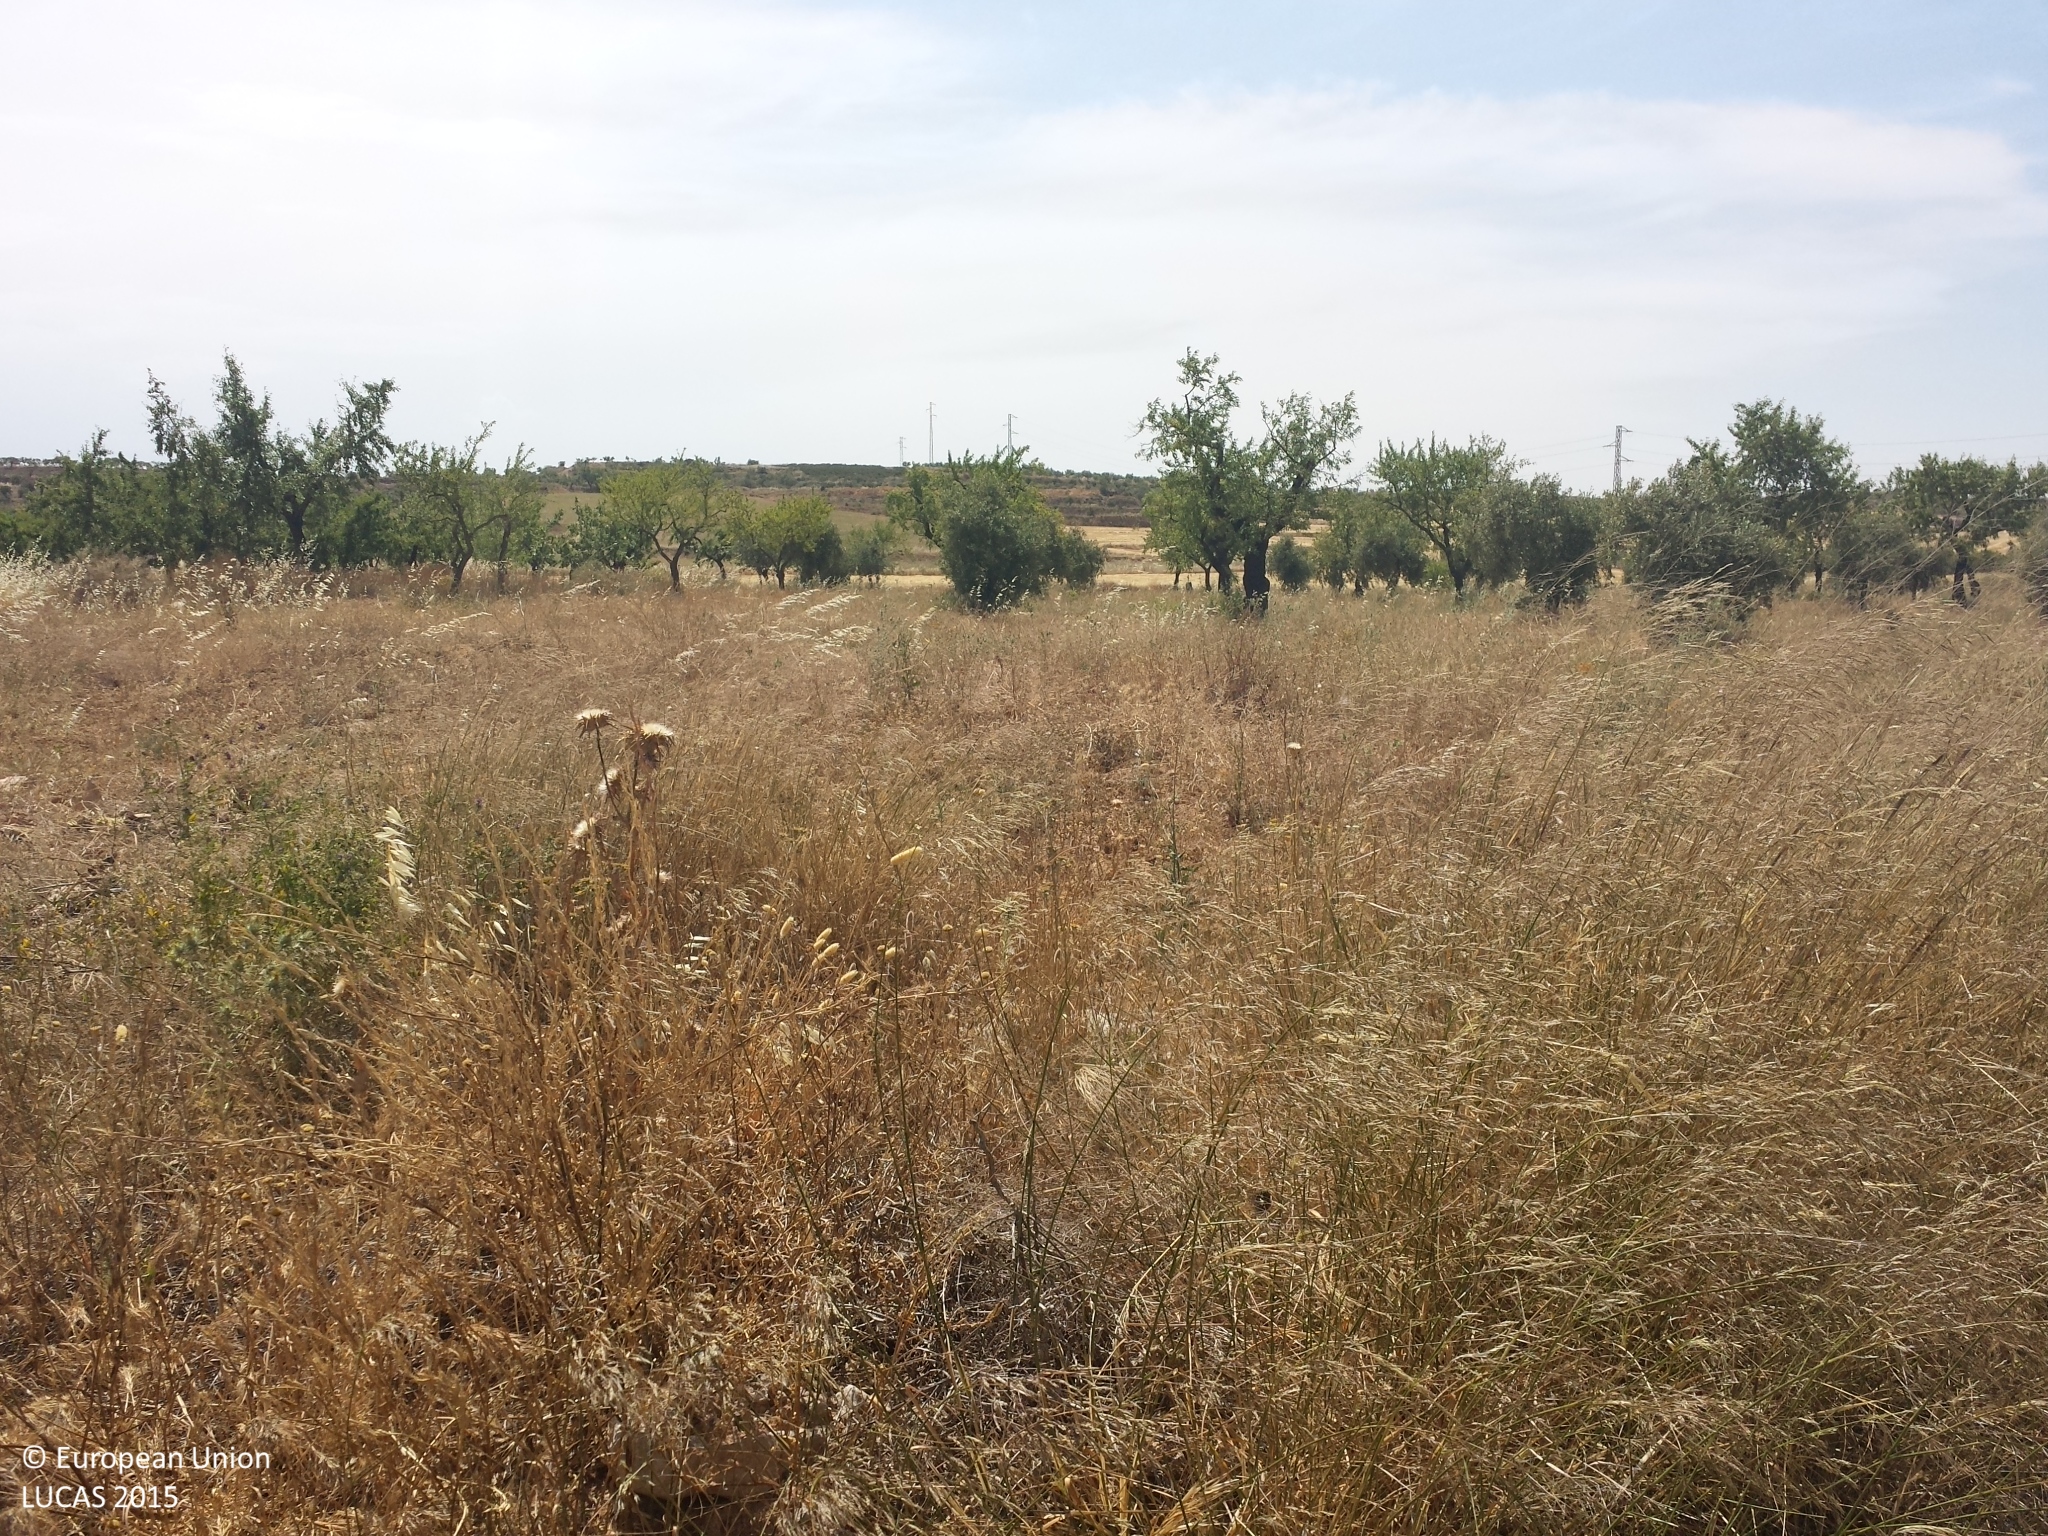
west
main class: Grassland
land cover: Grassland without tree/shrub cover
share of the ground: 50 - 75 %
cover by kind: herbaceous plants 60 %, unconsolidated bare surface 30 %, shrubs 5 %, consolidated bare surface 5 %
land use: Road transport
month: May
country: ES
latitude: 41.4899
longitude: 0.6101
